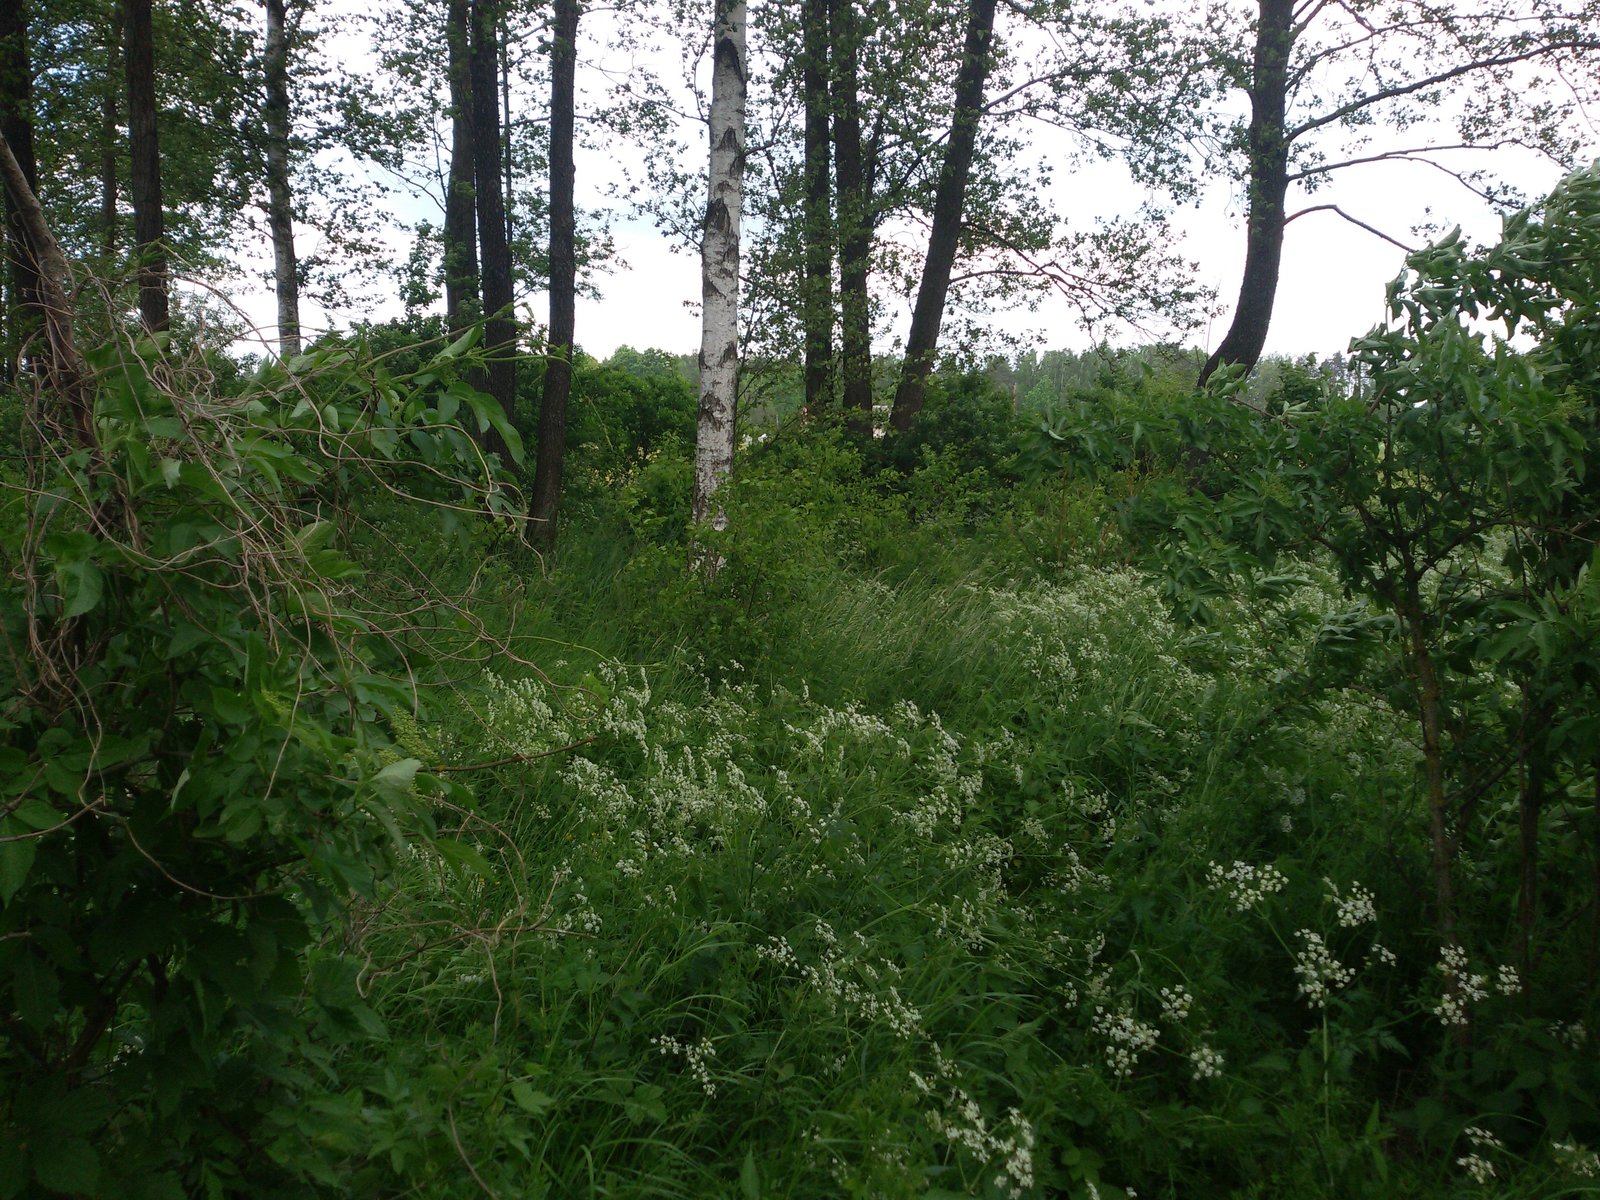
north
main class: Woodland
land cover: Broadleaved woodland
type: mesophytic deciduous forest
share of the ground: 50 - 75 %
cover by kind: broadleaved forest trees 50 %, herbaceous plants 40 %, shrubs 10 %
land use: Forestry
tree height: > 5 m
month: May
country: PL
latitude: 53.4420
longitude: 21.0187
